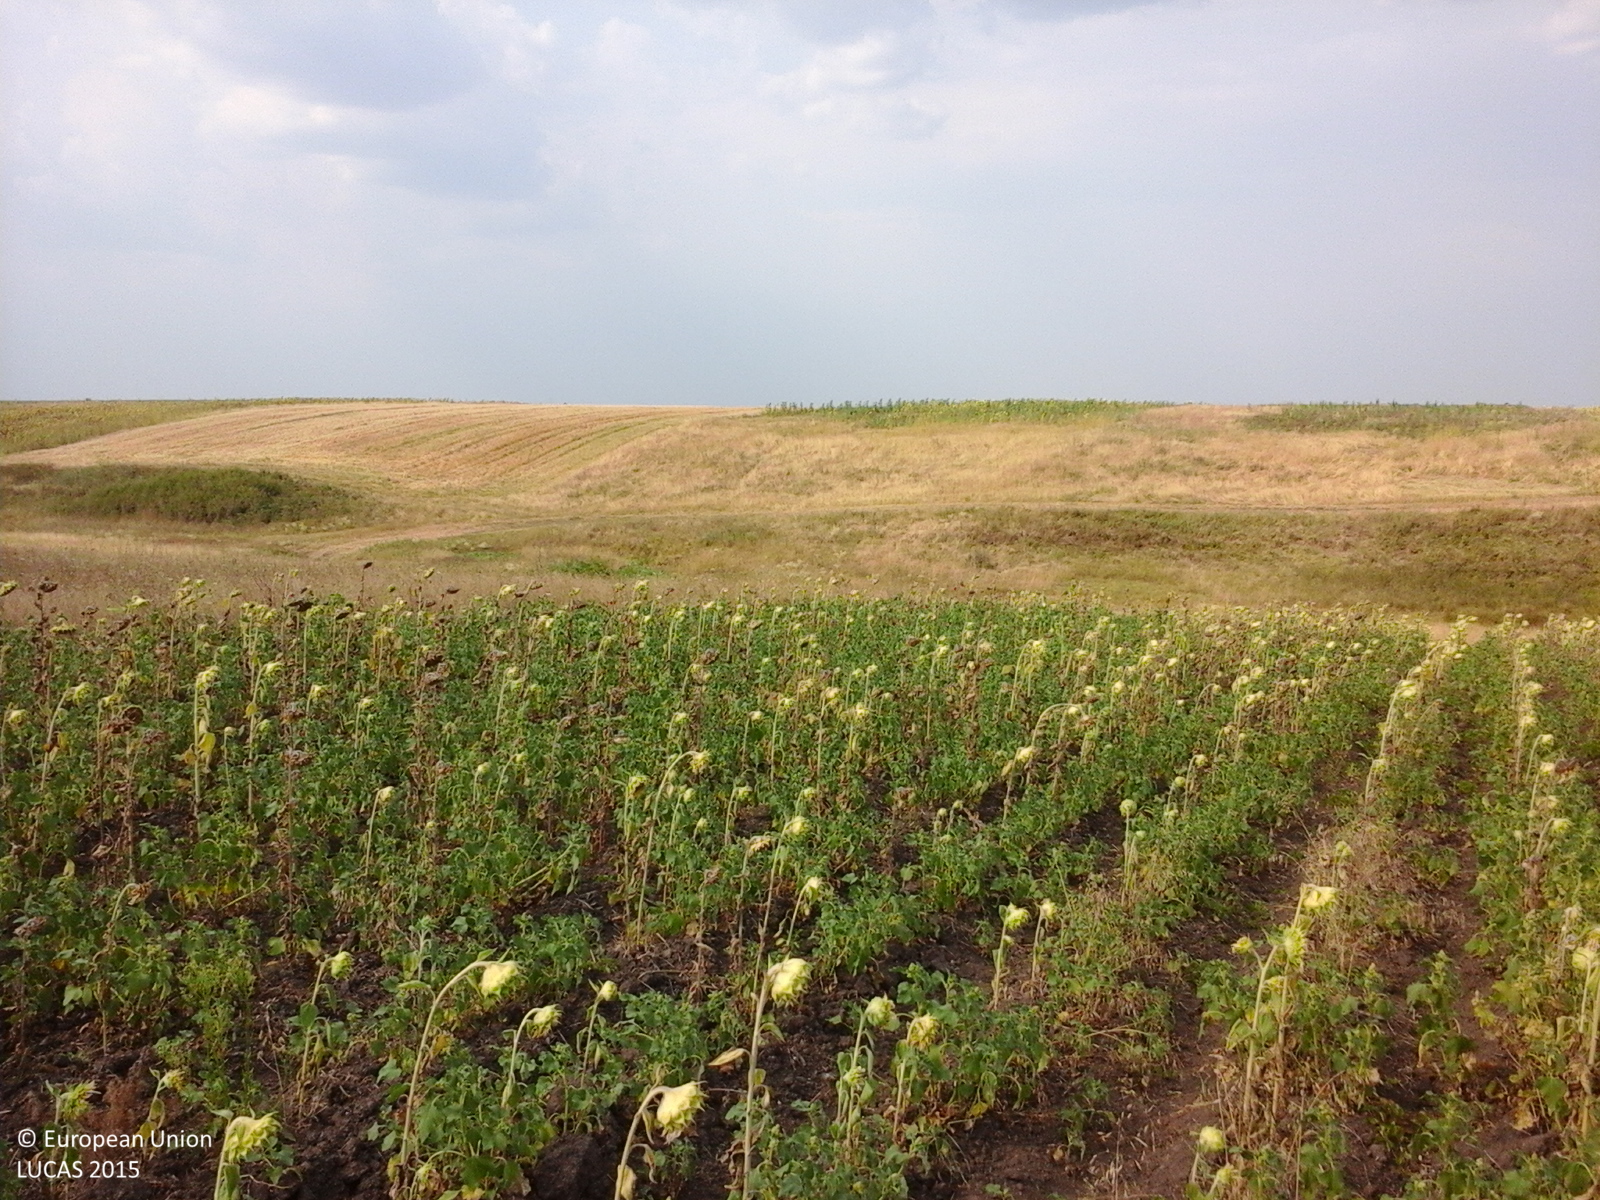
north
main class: Cropland
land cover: Sunflower
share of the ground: > 75 %
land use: Agriculture (excluding fallow land and kitchen gardens)
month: August
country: RO
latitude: 44.3118
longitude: 23.2999
